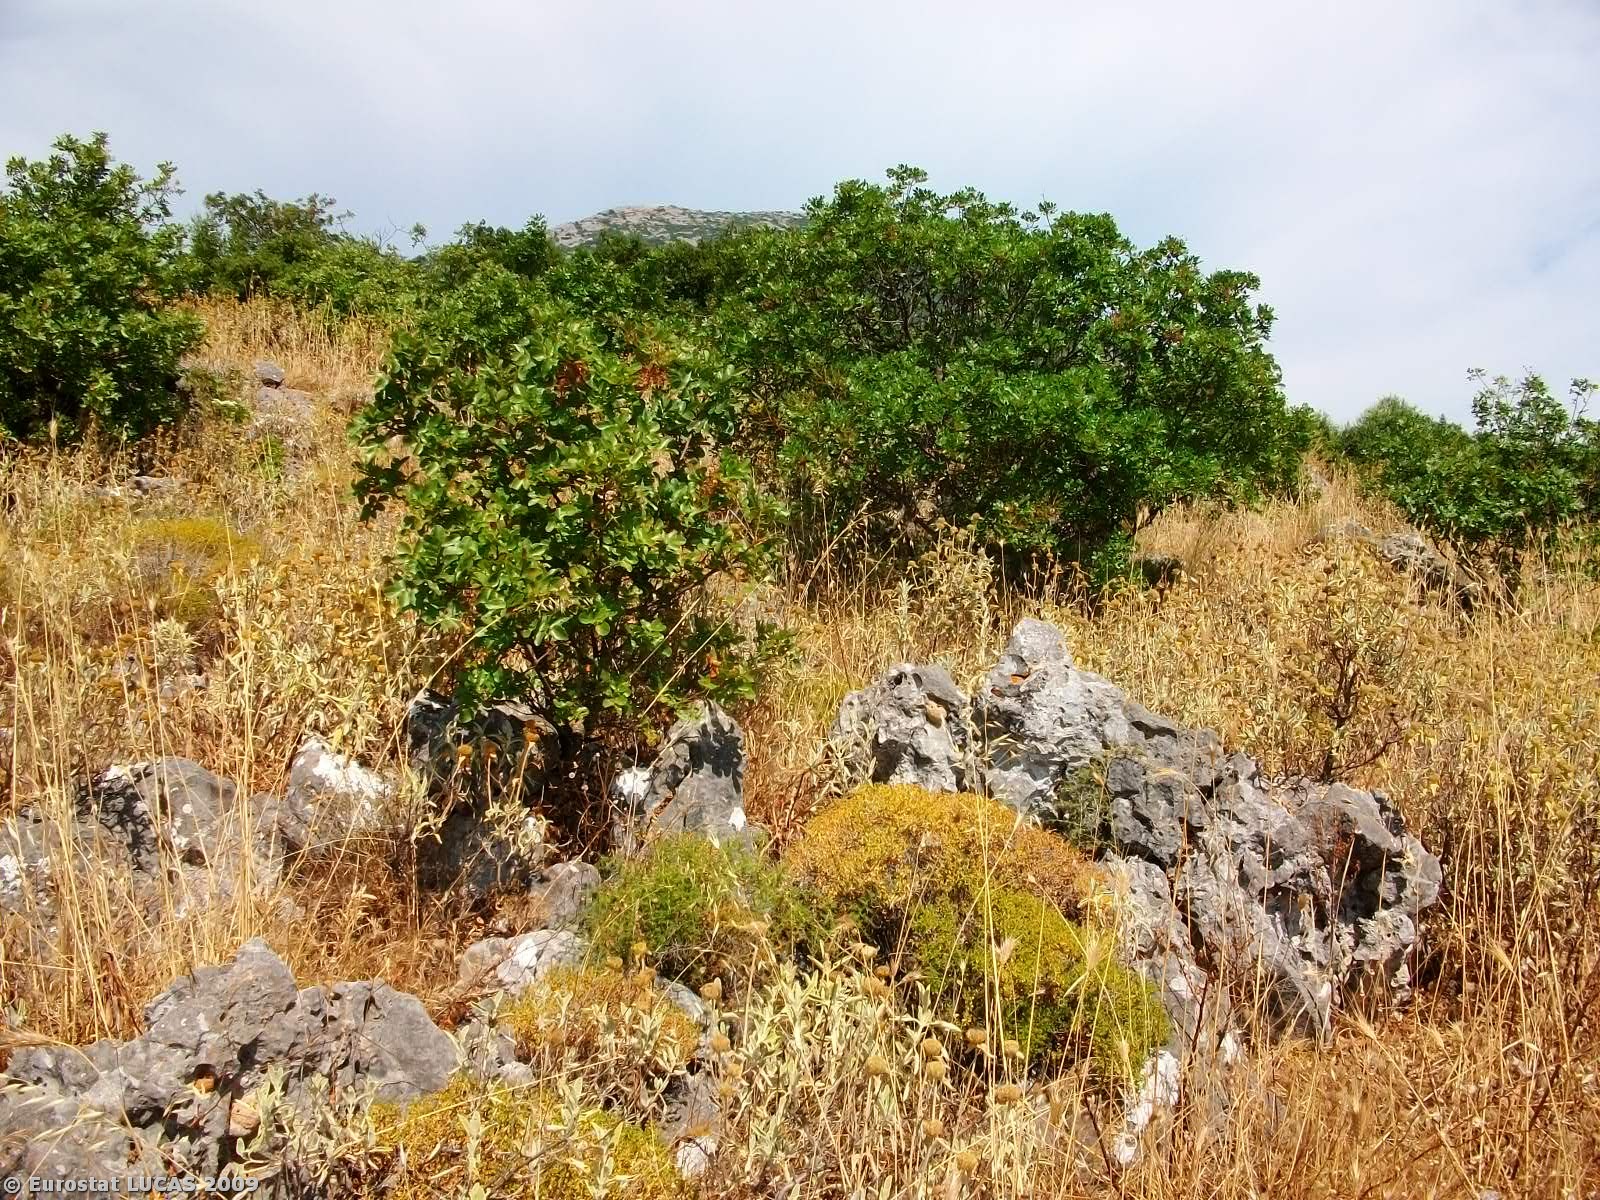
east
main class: Shrubland
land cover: Shrubland with sparse tree cover
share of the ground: > 75 %
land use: Unused
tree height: < 5 m
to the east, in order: Shrubland with sparse tree cover; Tracks; Olive groves; Grassland with sparse tree/shrub cover
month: June
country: GR
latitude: 36.7974
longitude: 22.3129
